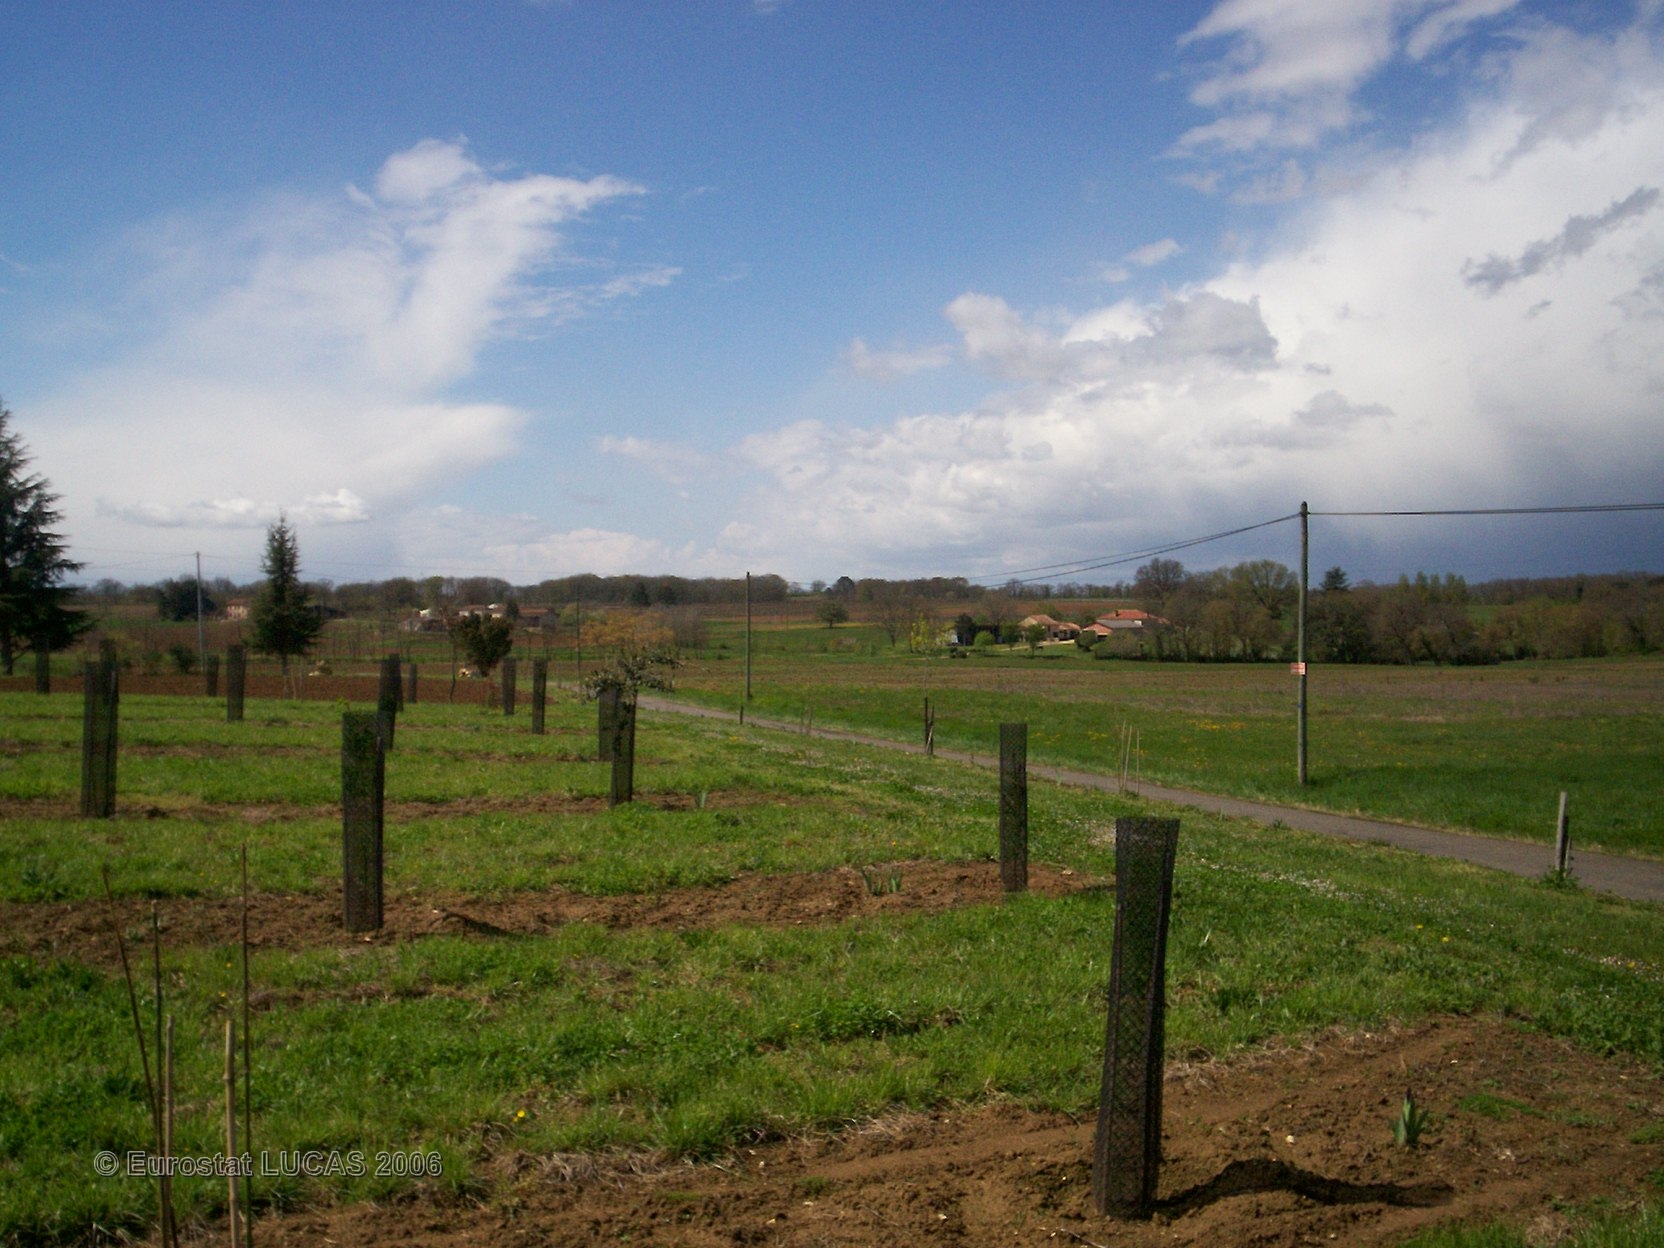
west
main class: Cropland
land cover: Floriculture and ornamental plants
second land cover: Grassland with sparse tree/shrub cover
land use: Agriculture (excluding fallow land and kitchen gardens)
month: April
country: FR
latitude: 43.9259
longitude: 0.2411
